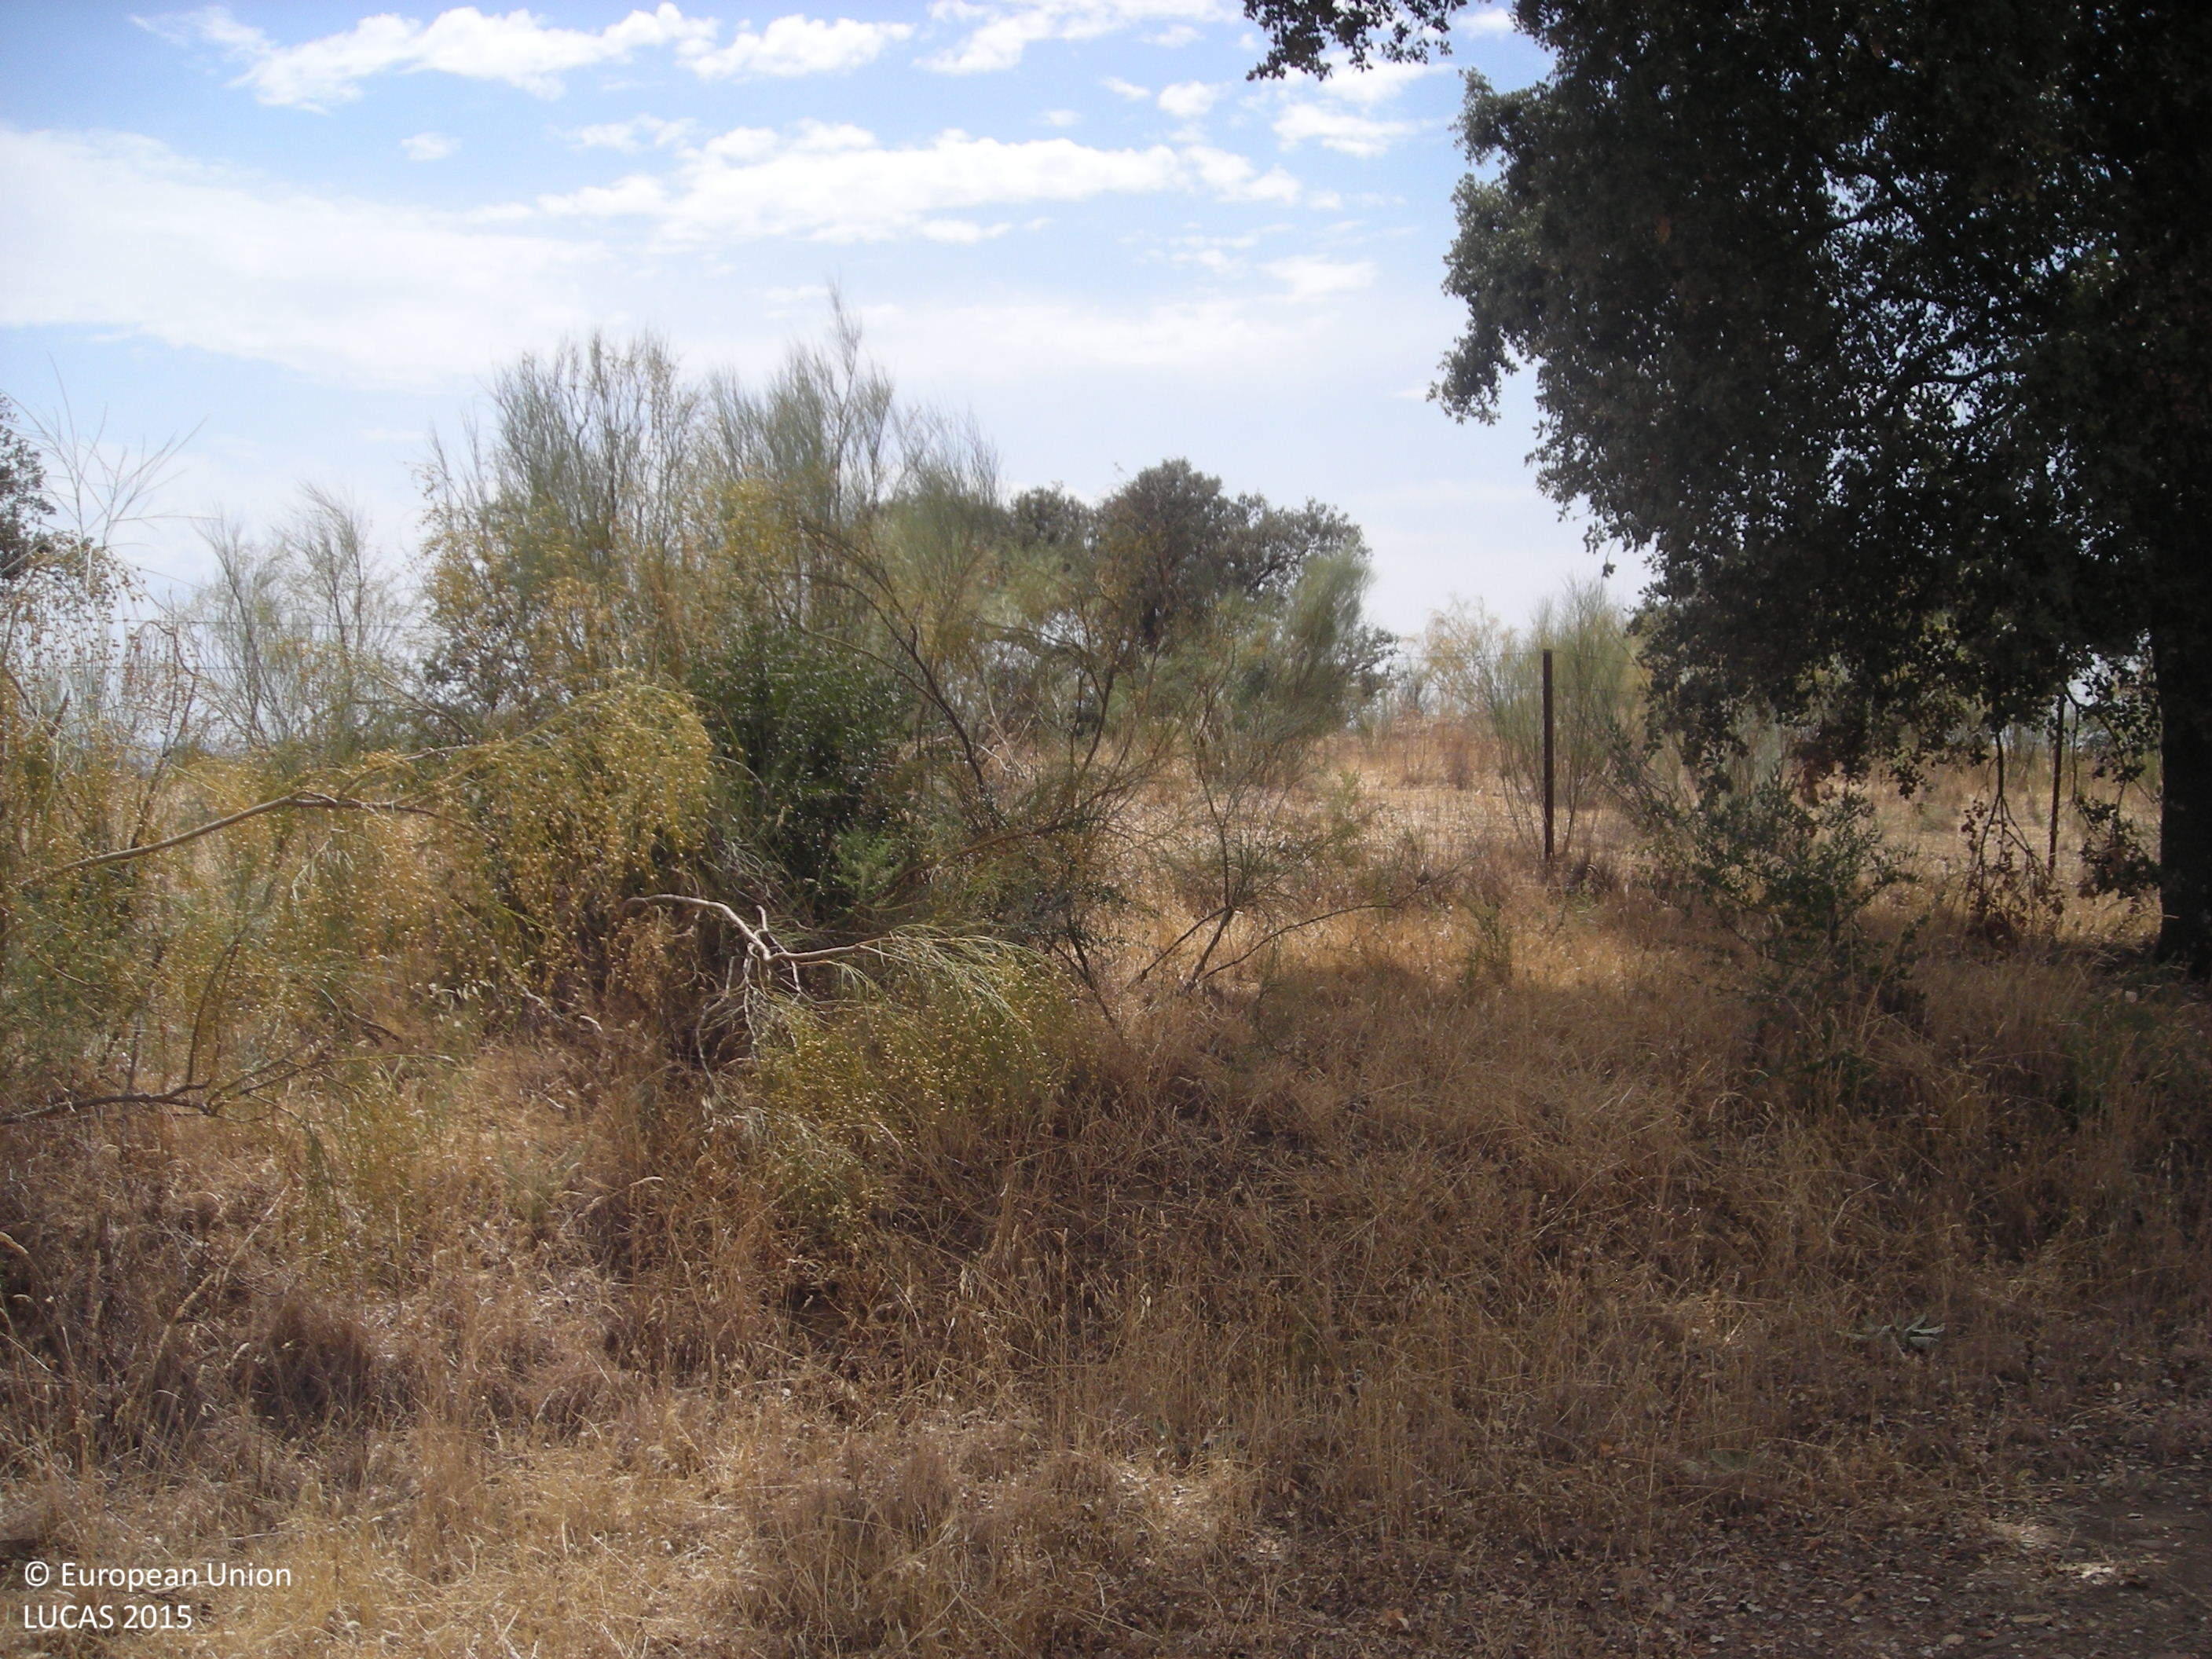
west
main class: Woodland
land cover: Broadleaved woodland
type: broadleaved evergreen forest
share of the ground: > 75 %
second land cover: Grassland without tree/shrub cover
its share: 50 - 75 %
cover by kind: broadleaved forest trees 70 %, herbaceous plants 30 %
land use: Forestry
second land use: Agriculture (excluding fallow land and kitchen gardens)
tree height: > 5 m
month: July
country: ES
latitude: 39.2023
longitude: -5.5533
